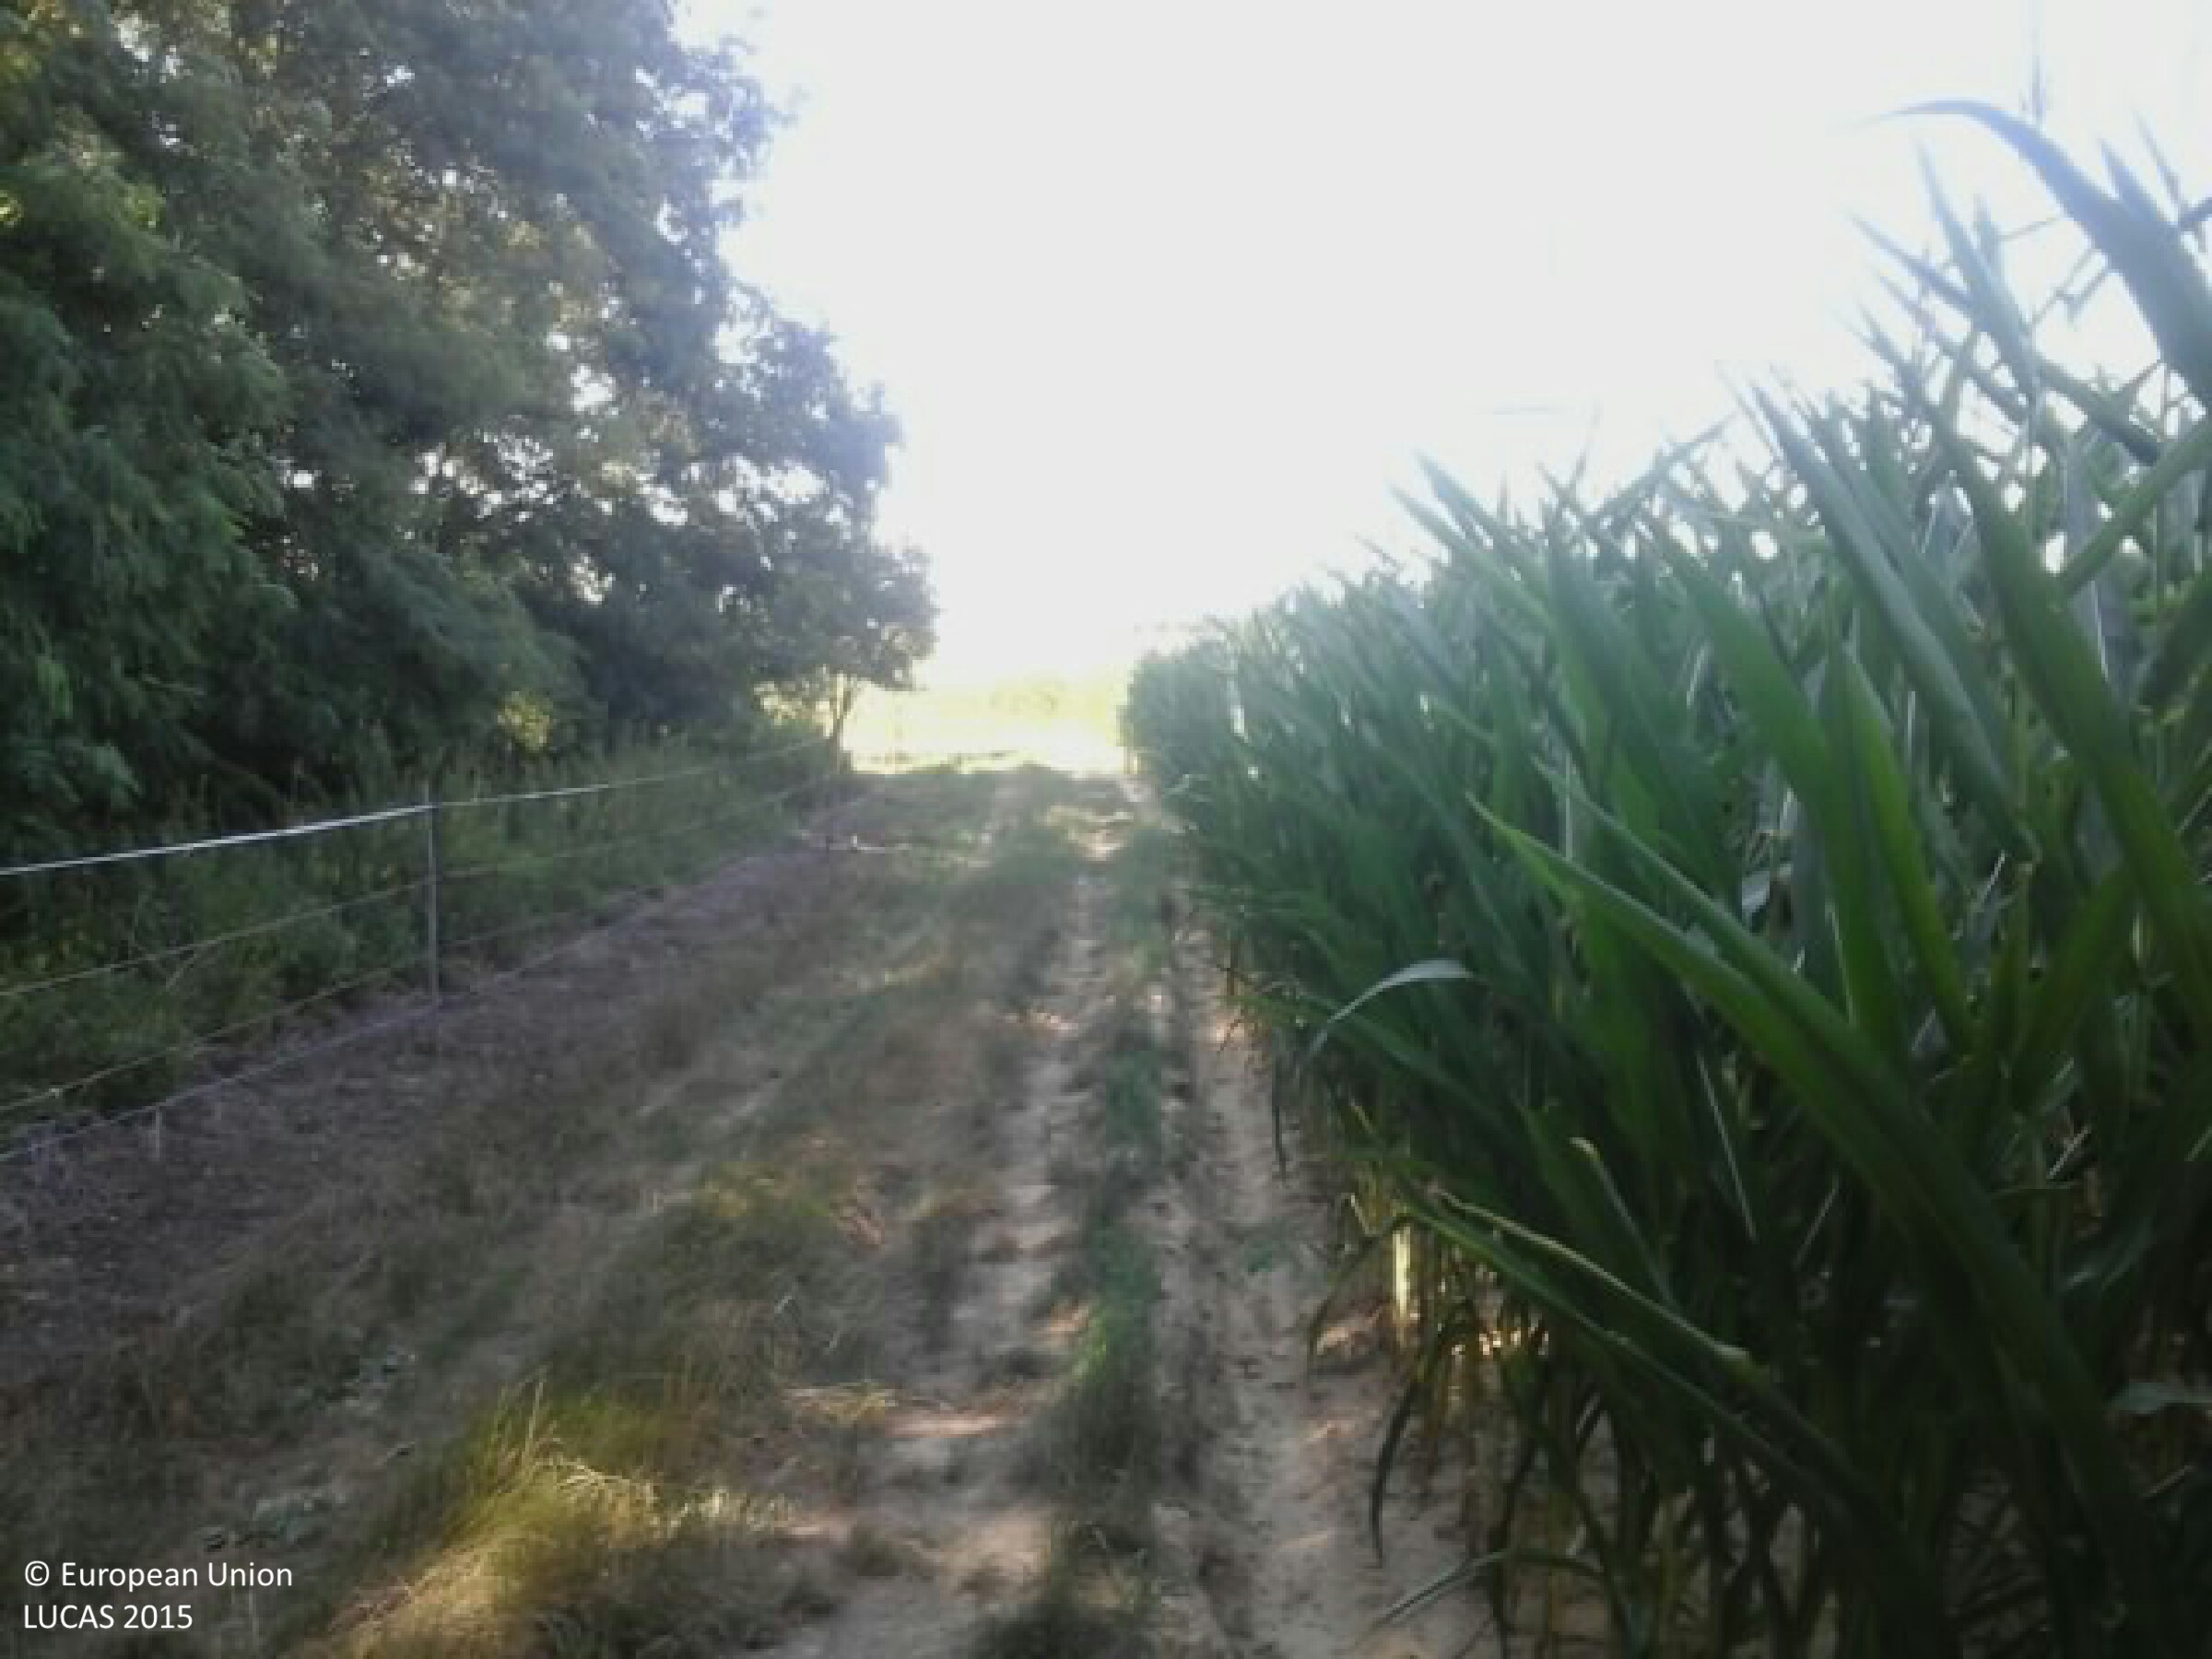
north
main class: Cropland
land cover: Maize
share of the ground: > 75 %
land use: Agriculture (excluding fallow land and kitchen gardens)
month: July
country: HU
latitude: 46.2223
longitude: 17.1199
